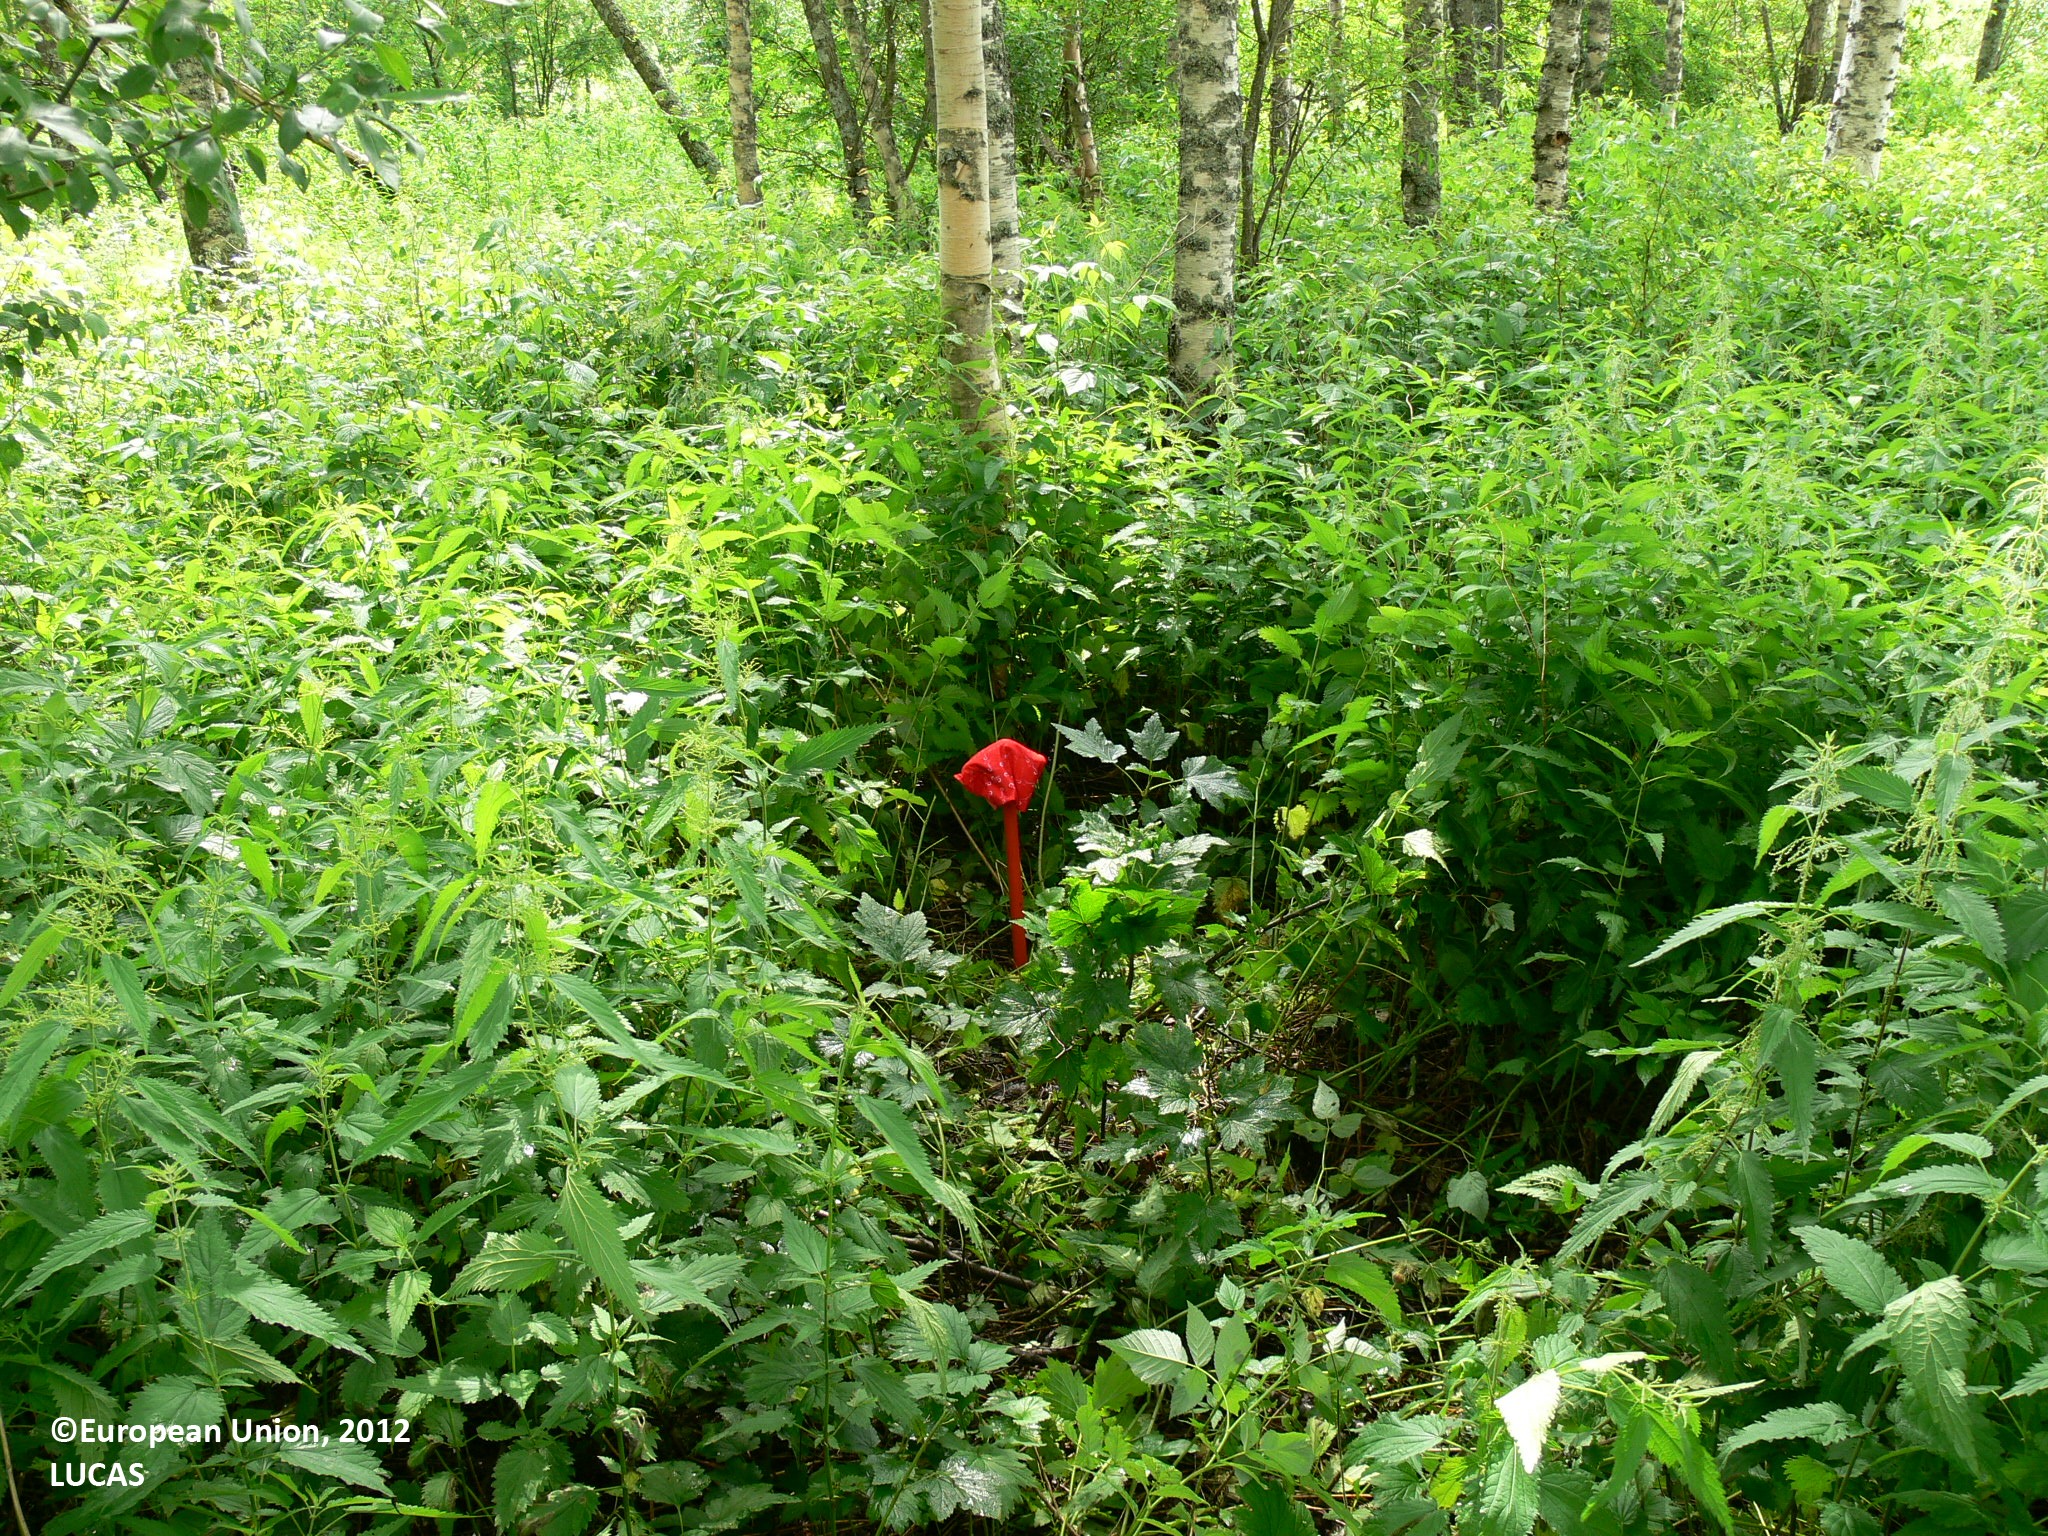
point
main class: Woodland
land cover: Broadleaved woodland
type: boreal forest
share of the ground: > 75 %
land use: Forestry
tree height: > 5 m
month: July
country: FI
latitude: 63.1694
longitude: 30.0536
